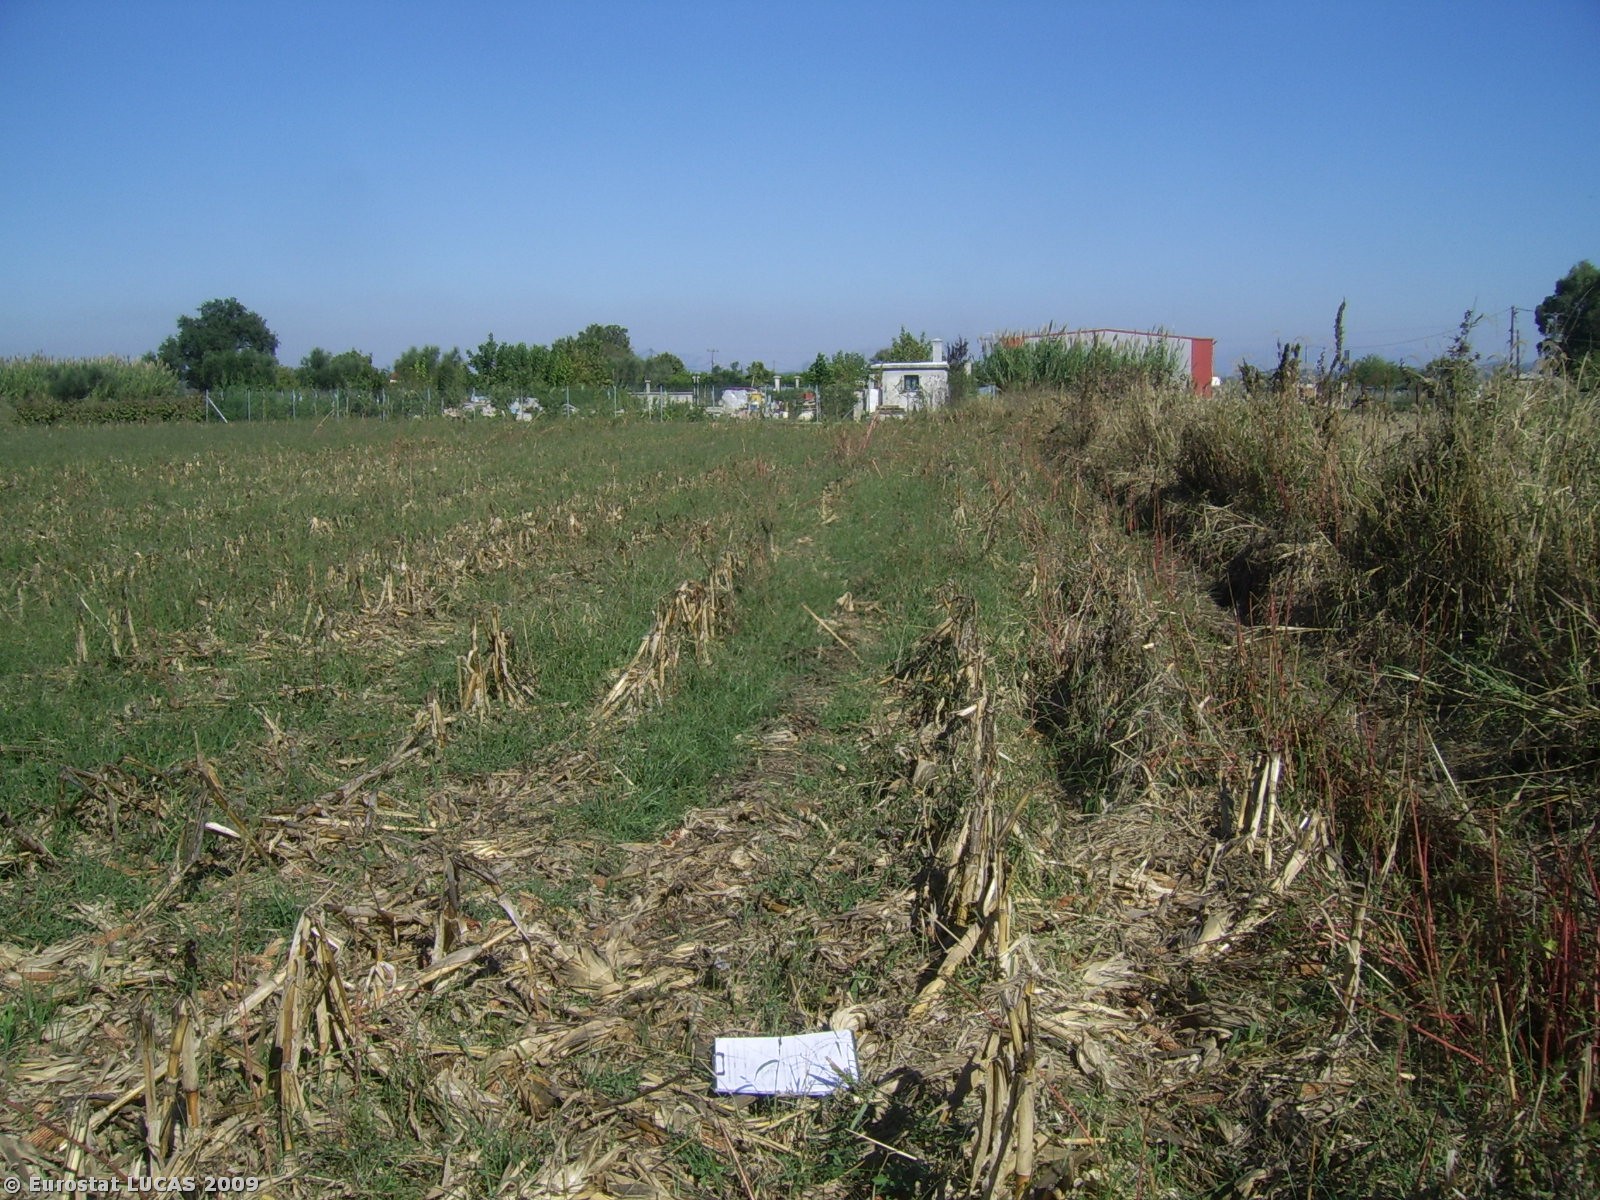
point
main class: Cropland
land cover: Maize
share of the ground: < 10 %
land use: Agriculture (excluding fallow land and kitchen gardens)
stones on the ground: < 10 %
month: October
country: GR
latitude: 37.8207
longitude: 21.3088
